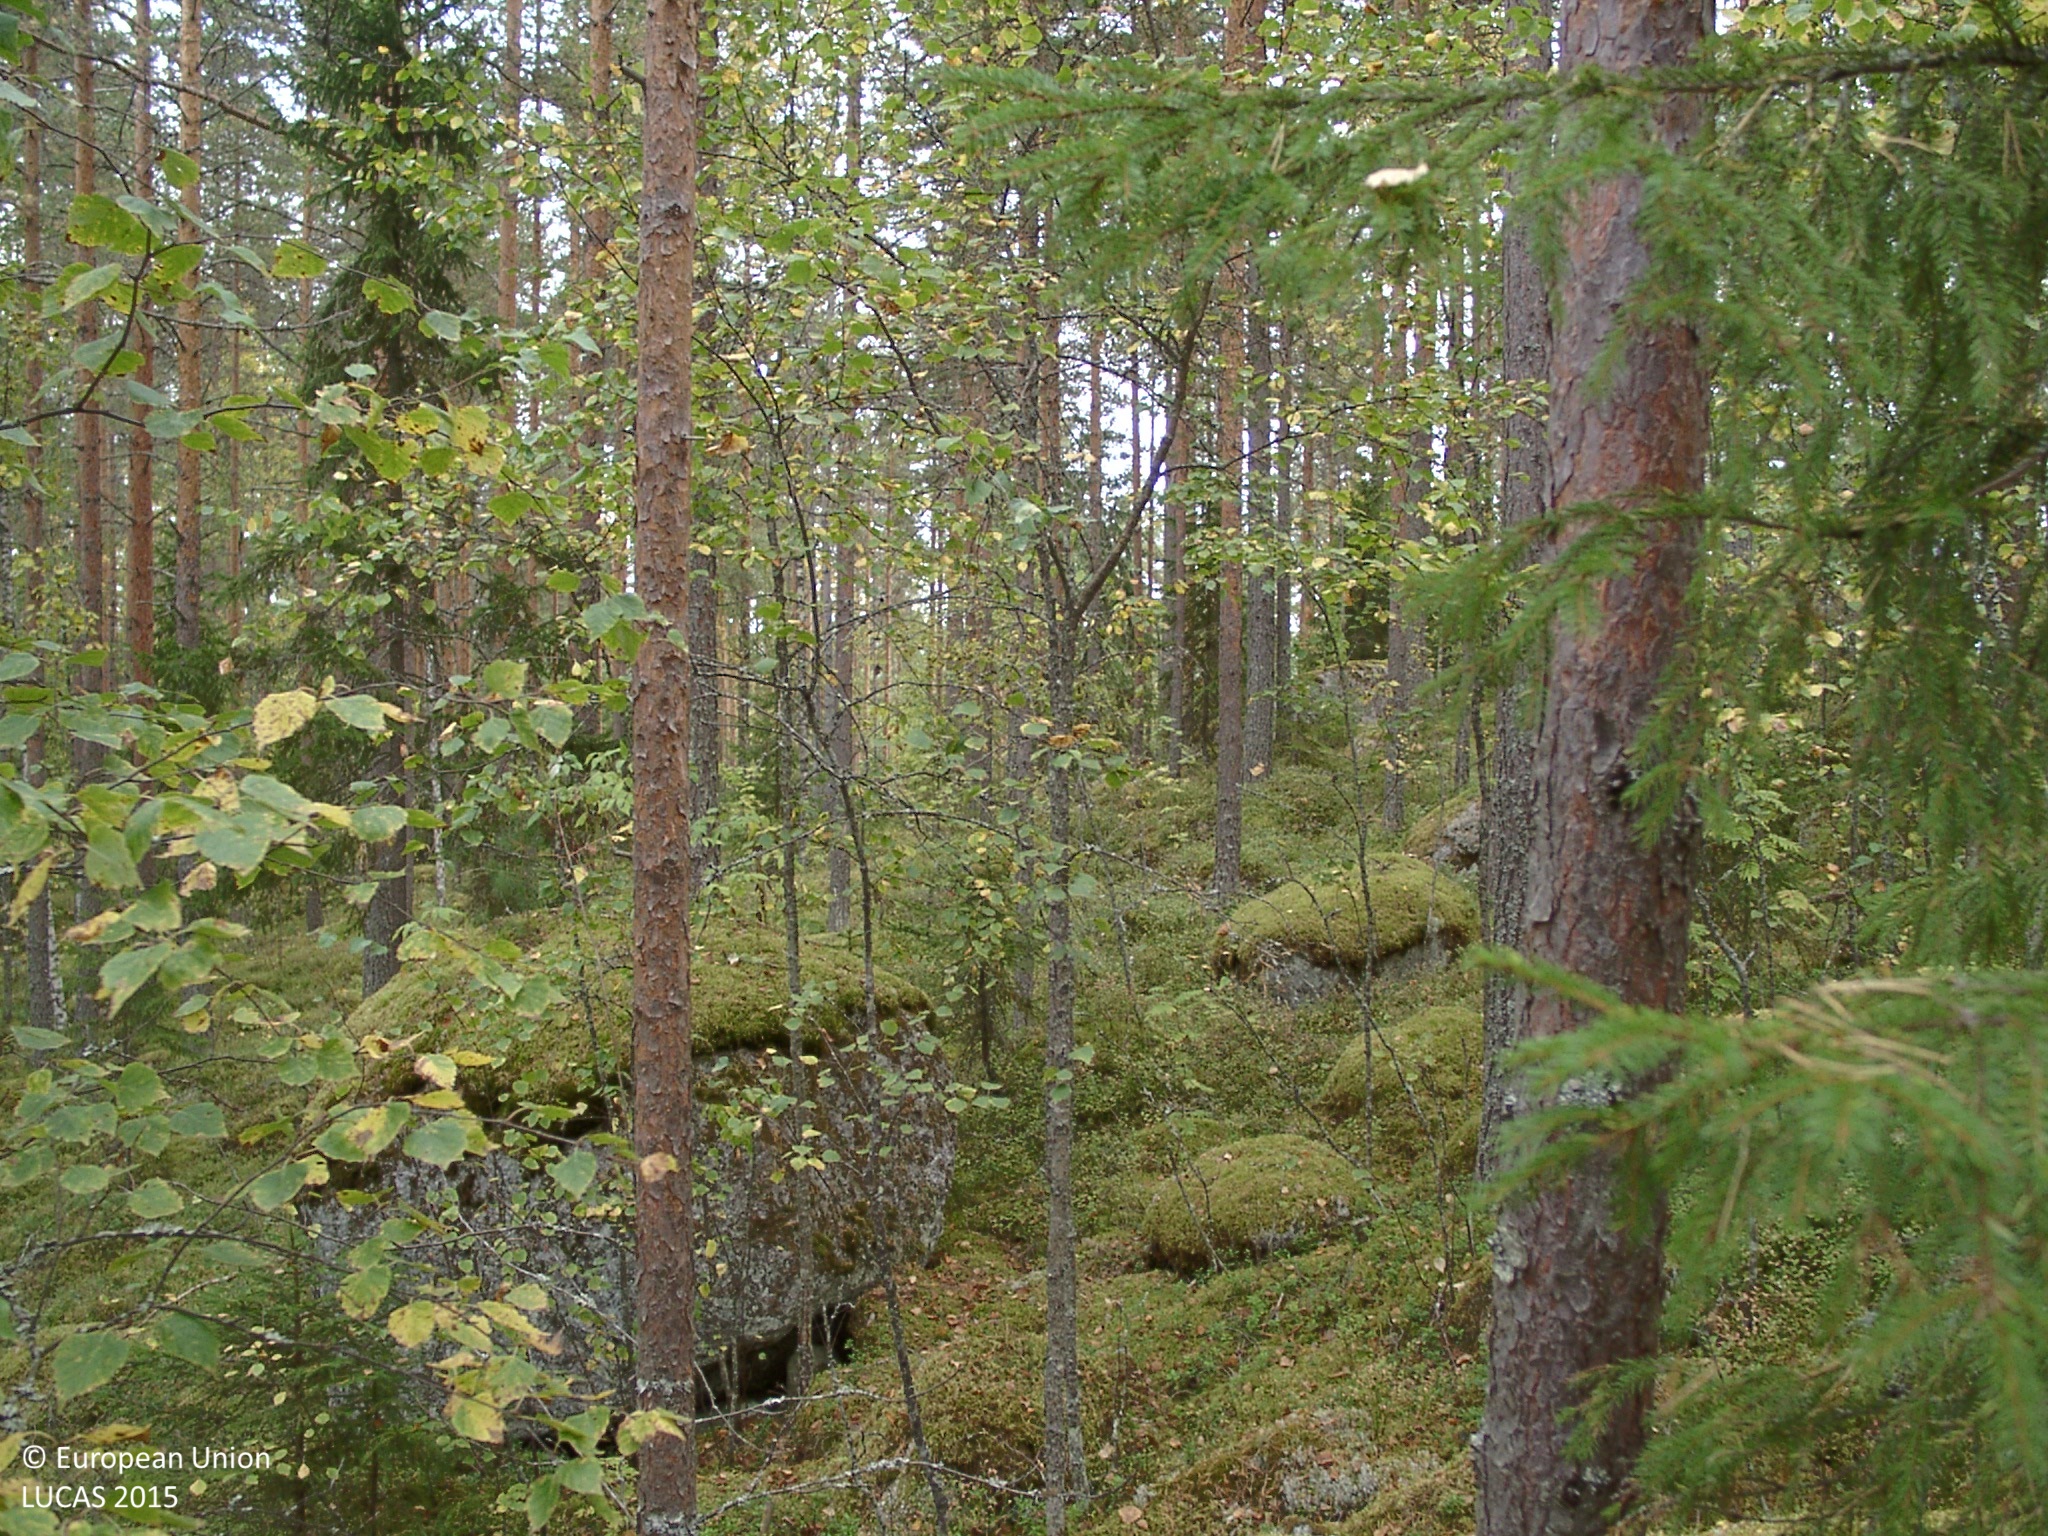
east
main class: Woodland
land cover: Pine dominated coniferous woodland
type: boreal forest
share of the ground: > 75 %
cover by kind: coniferous forest trees 80 %, lichens and mosses 10 %, broadleaved forest trees 5 %, shrubs 5 %
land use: Forestry
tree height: > 5 m
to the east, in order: Pine dominated coniferous woodland; Tracks; Pine dominated coniferous woodland; Other mixed woodland; Shruby margins; Electric lines; Spruce dominated mixed woodland; Shruby margins; Ditches and canals; Managed hedges; Railways; Shruby margins; Ditches and canals; Shruby margins; Spruce dominated mixed woodland; Paved roads, cycling and walking lanes; Electric lines; Spruce dominated mixed woodland
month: September
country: FI
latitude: 62.5581
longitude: 25.8553
